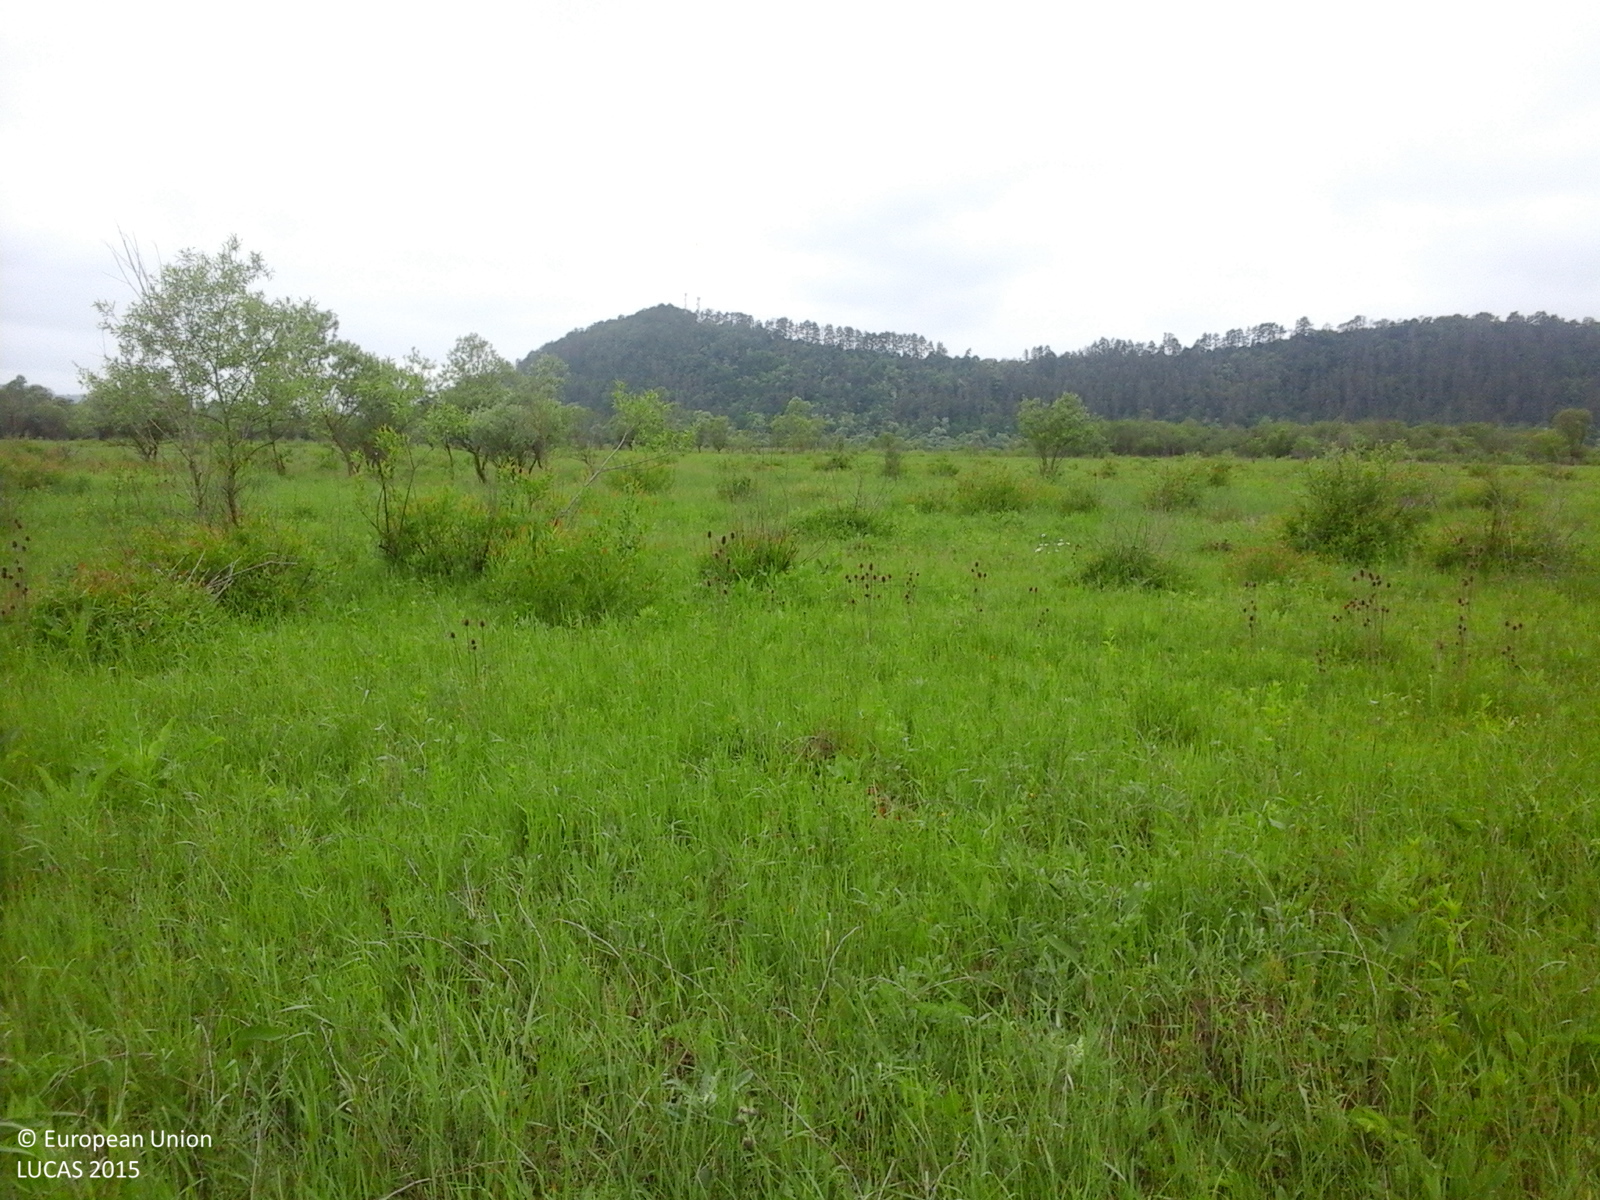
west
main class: Shrubland
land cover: Shrubland with sparse tree cover
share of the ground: > 75 %
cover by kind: herbaceous plants 85 %, shrubs 10 %, broadleaved forest trees 5 %
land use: Agriculture (excluding fallow land and kitchen gardens)
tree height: < 5 m
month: May
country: RO
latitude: 45.9309
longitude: 25.2256
